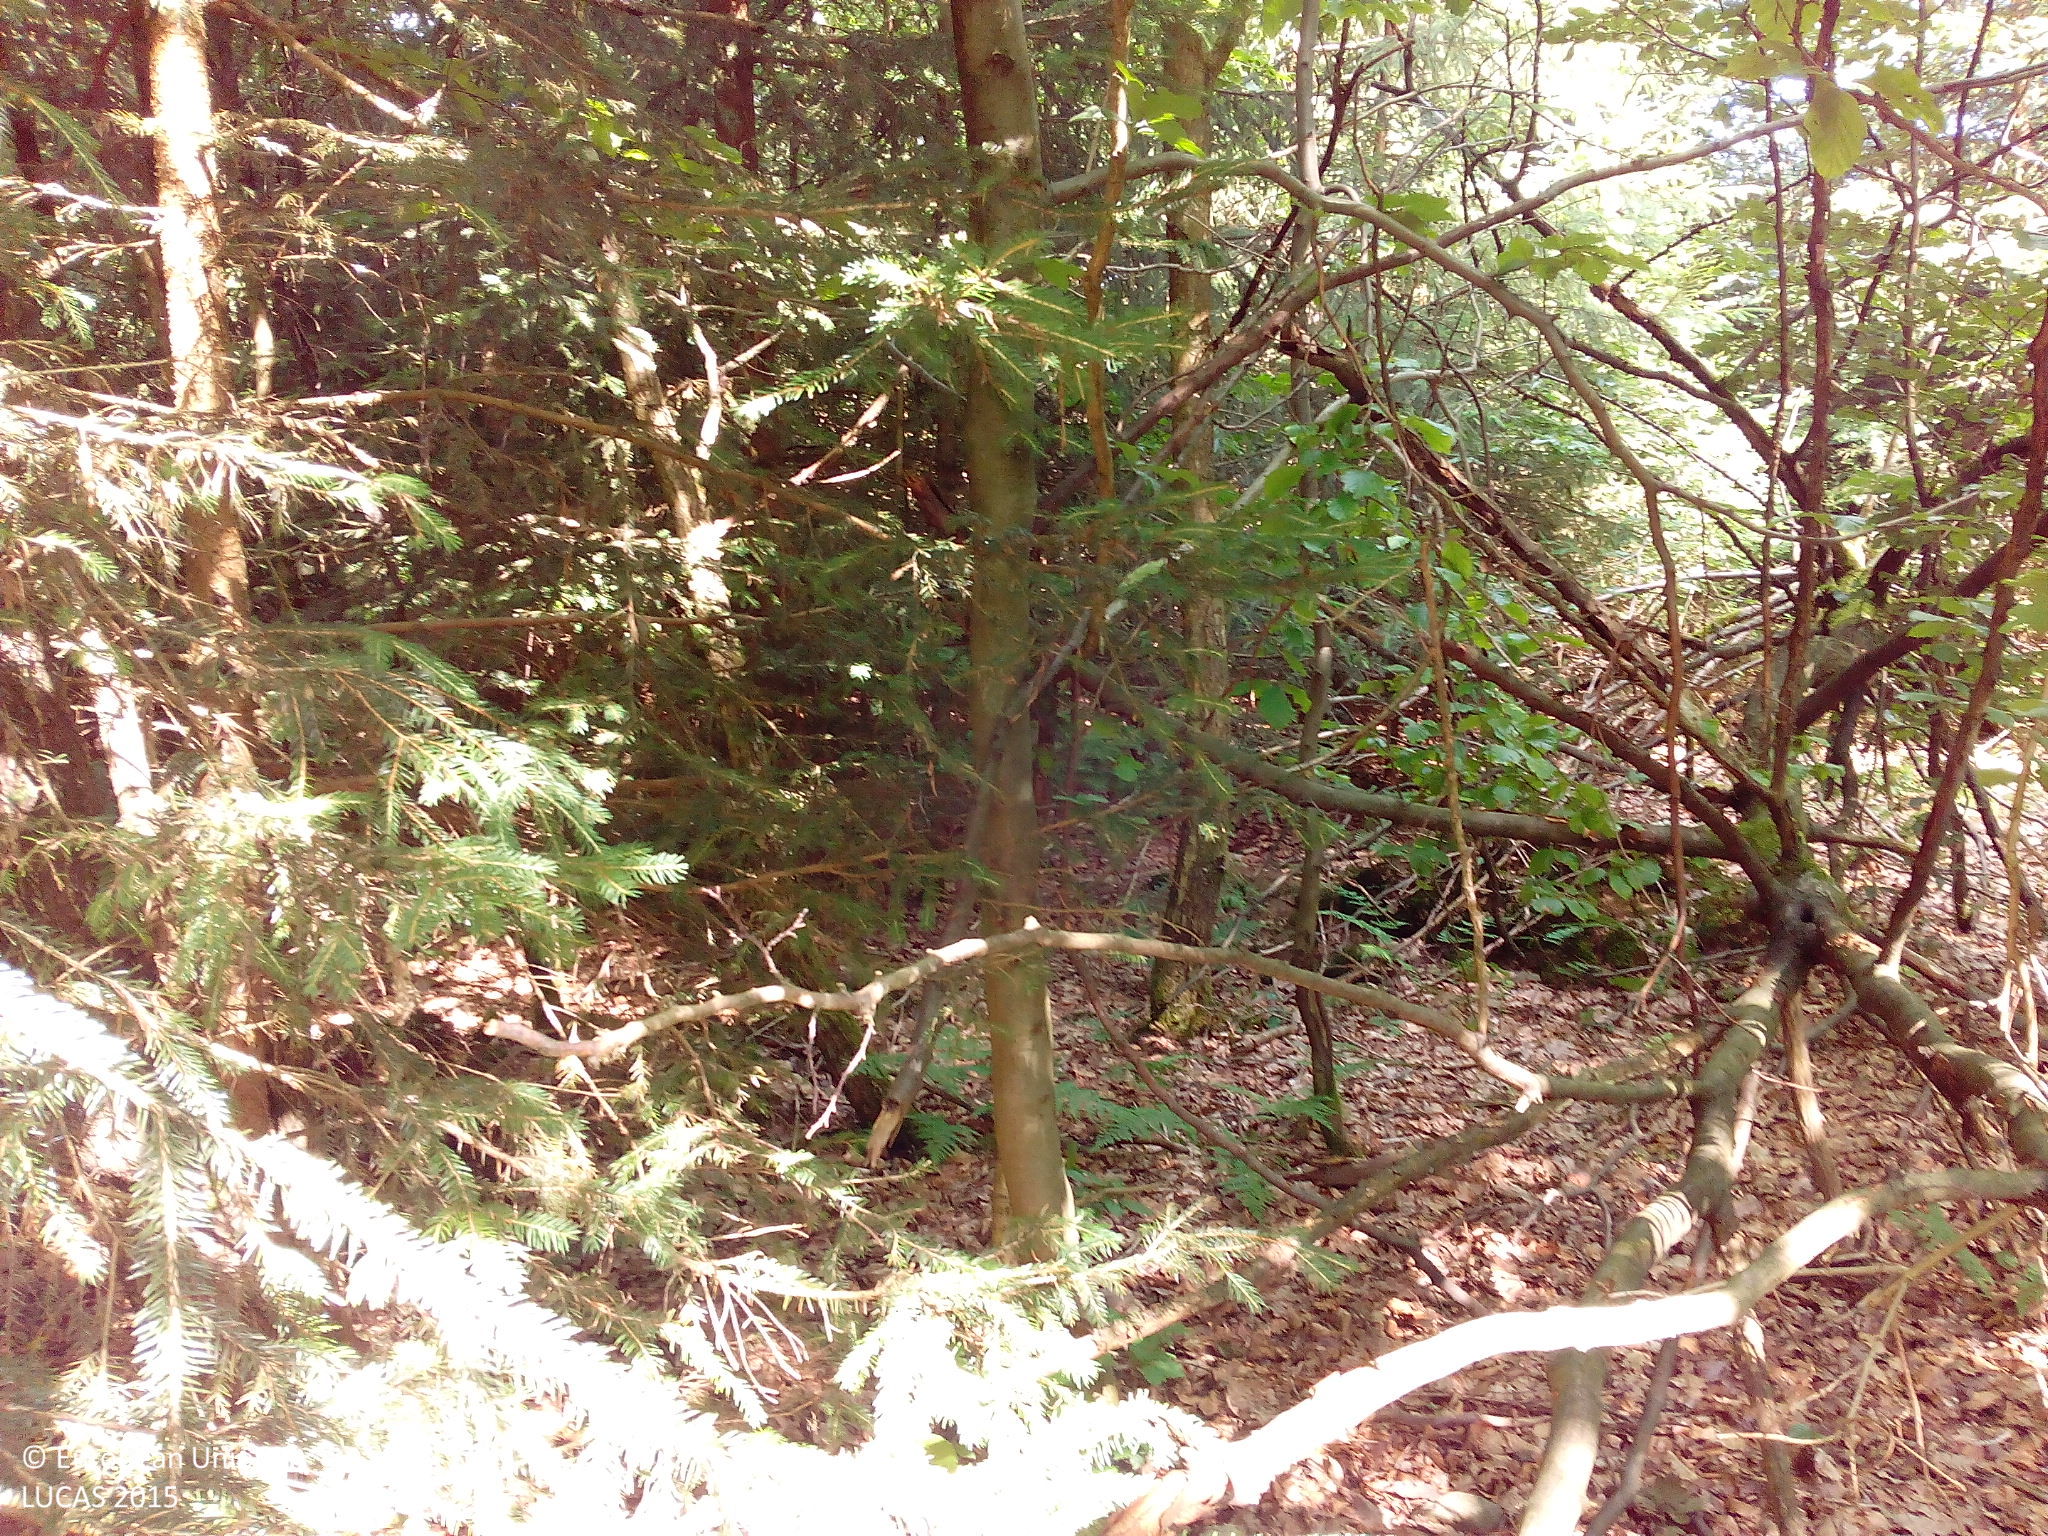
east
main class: Woodland
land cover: Spruce dominated mixed woodland
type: hemiboreal forest and nemoral coniferous forest and mixed broadleaved-coniferous forest
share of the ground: > 75 %
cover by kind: coniferous forest trees 60 %, broadleaved forest trees 40 %
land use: Forestry
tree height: > 5 m
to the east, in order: Spruce dominated mixed woodland; Broadleaved woodland; Spruce dominated coniferous woodland; Spruce dominated mixed woodland; Rivers and streams; Spruce dominated coniferous woodland; Rivers and streams; Spruce dominated mixed woodland; Grassland without tree/shrub cover
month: July
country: DE
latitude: 50.6157
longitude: 9.8728
